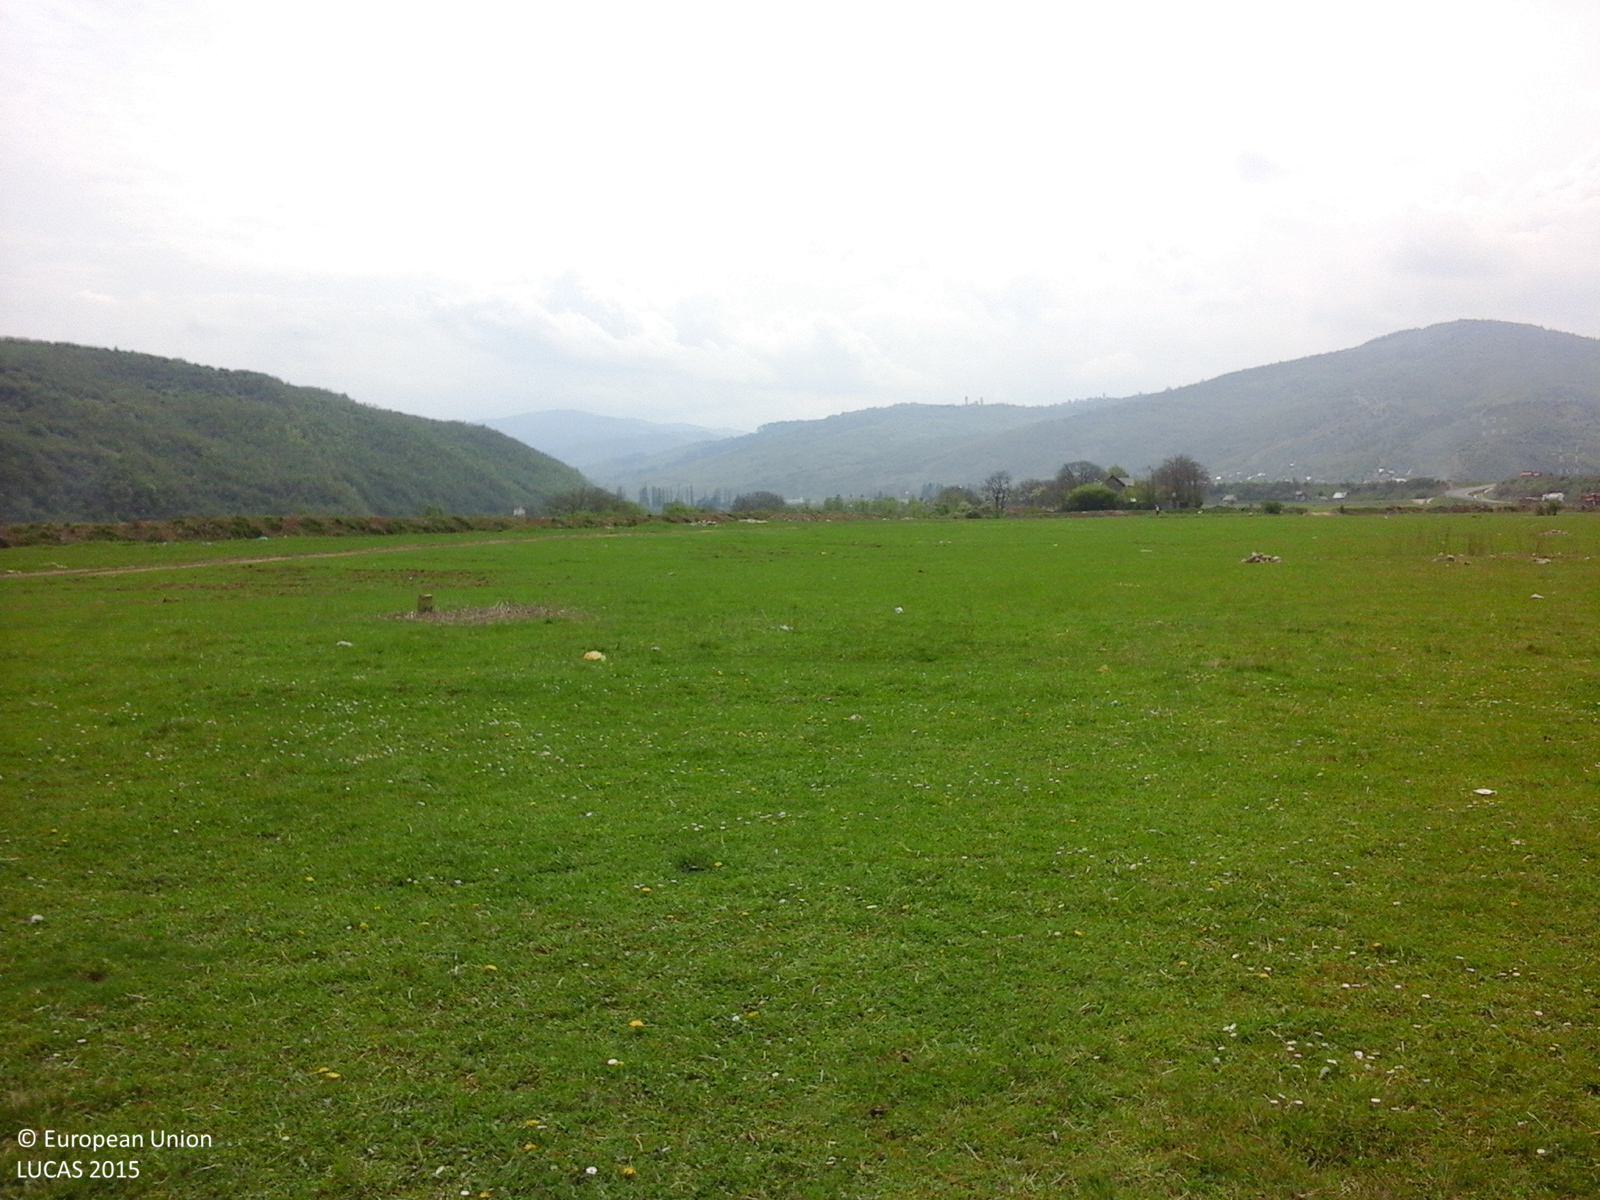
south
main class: Grassland
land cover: Grassland without tree/shrub cover
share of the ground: > 75 %
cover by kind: herbaceous plants 100 %
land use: Agriculture (excluding fallow land and kitchen gardens)
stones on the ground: < 10 %
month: May
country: RO
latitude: 45.6167
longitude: 25.7402
